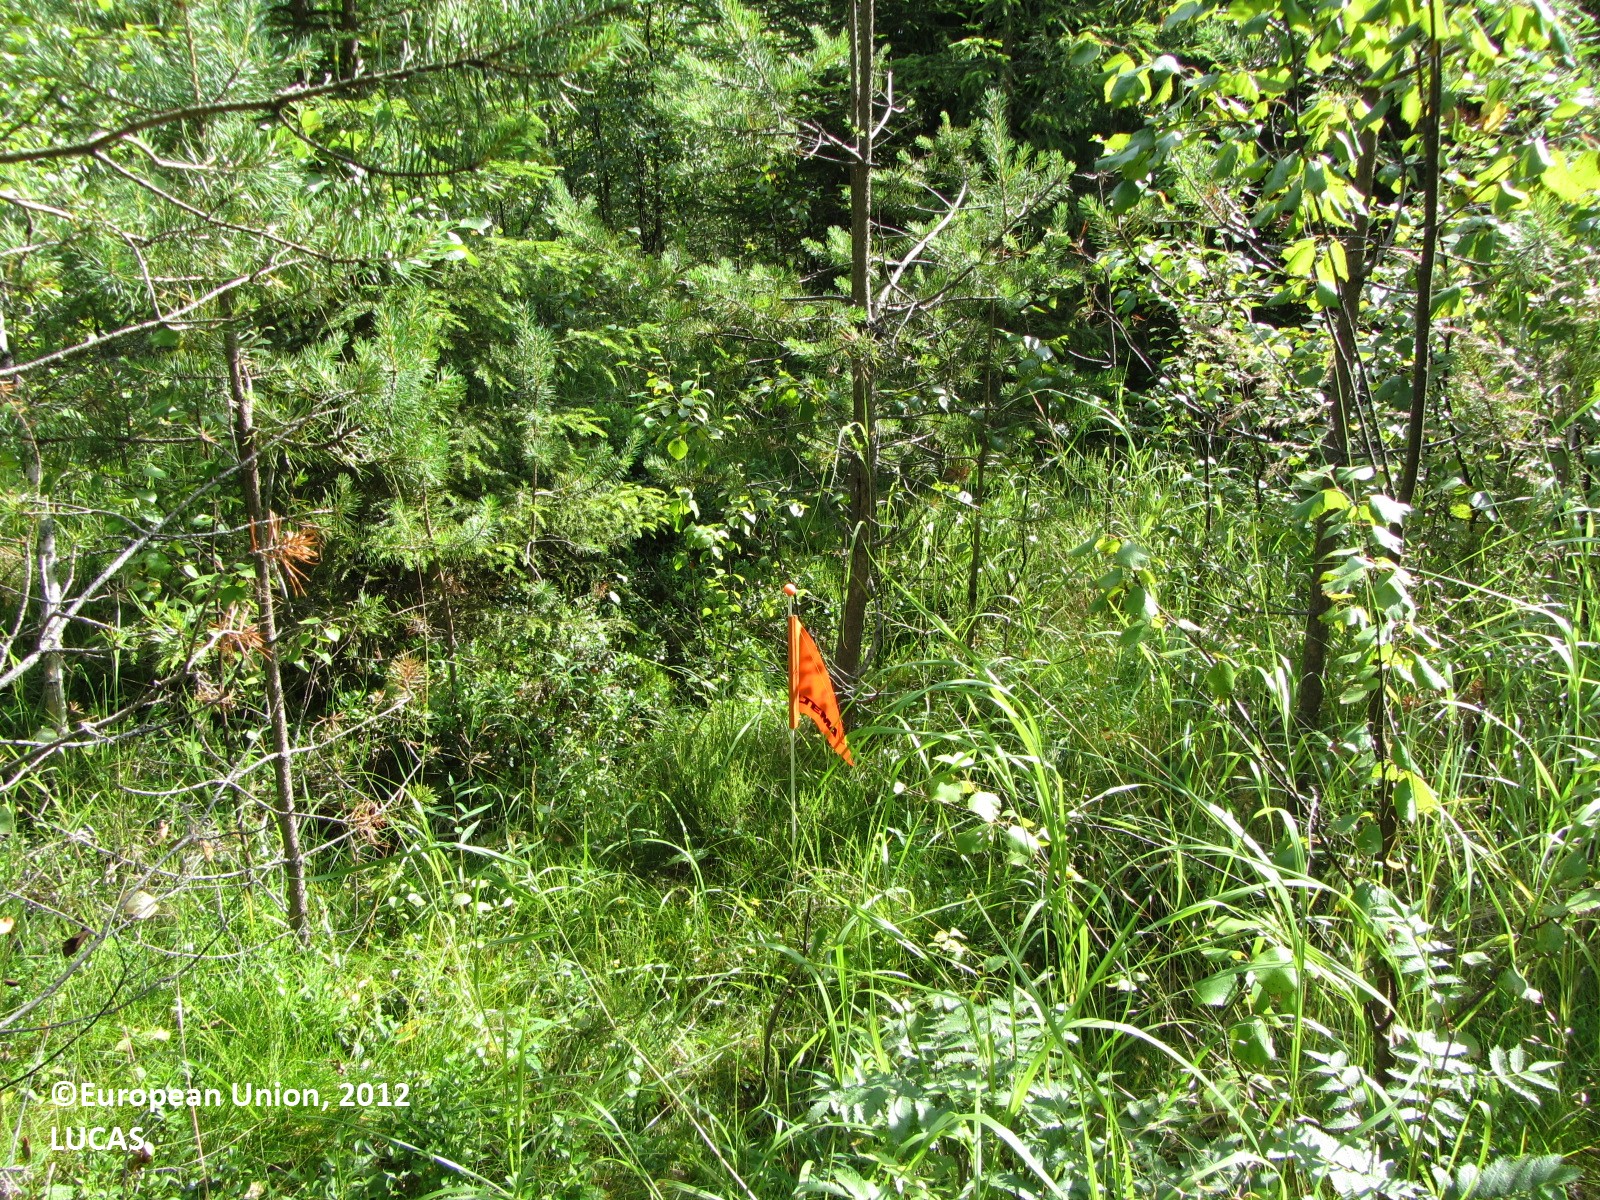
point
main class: Woodland
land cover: Other mixed woodland
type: boreal forest
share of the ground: 50 - 75 %
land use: Forestry
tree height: > 5 m
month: July
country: FI
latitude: 63.6797
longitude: 24.6148
